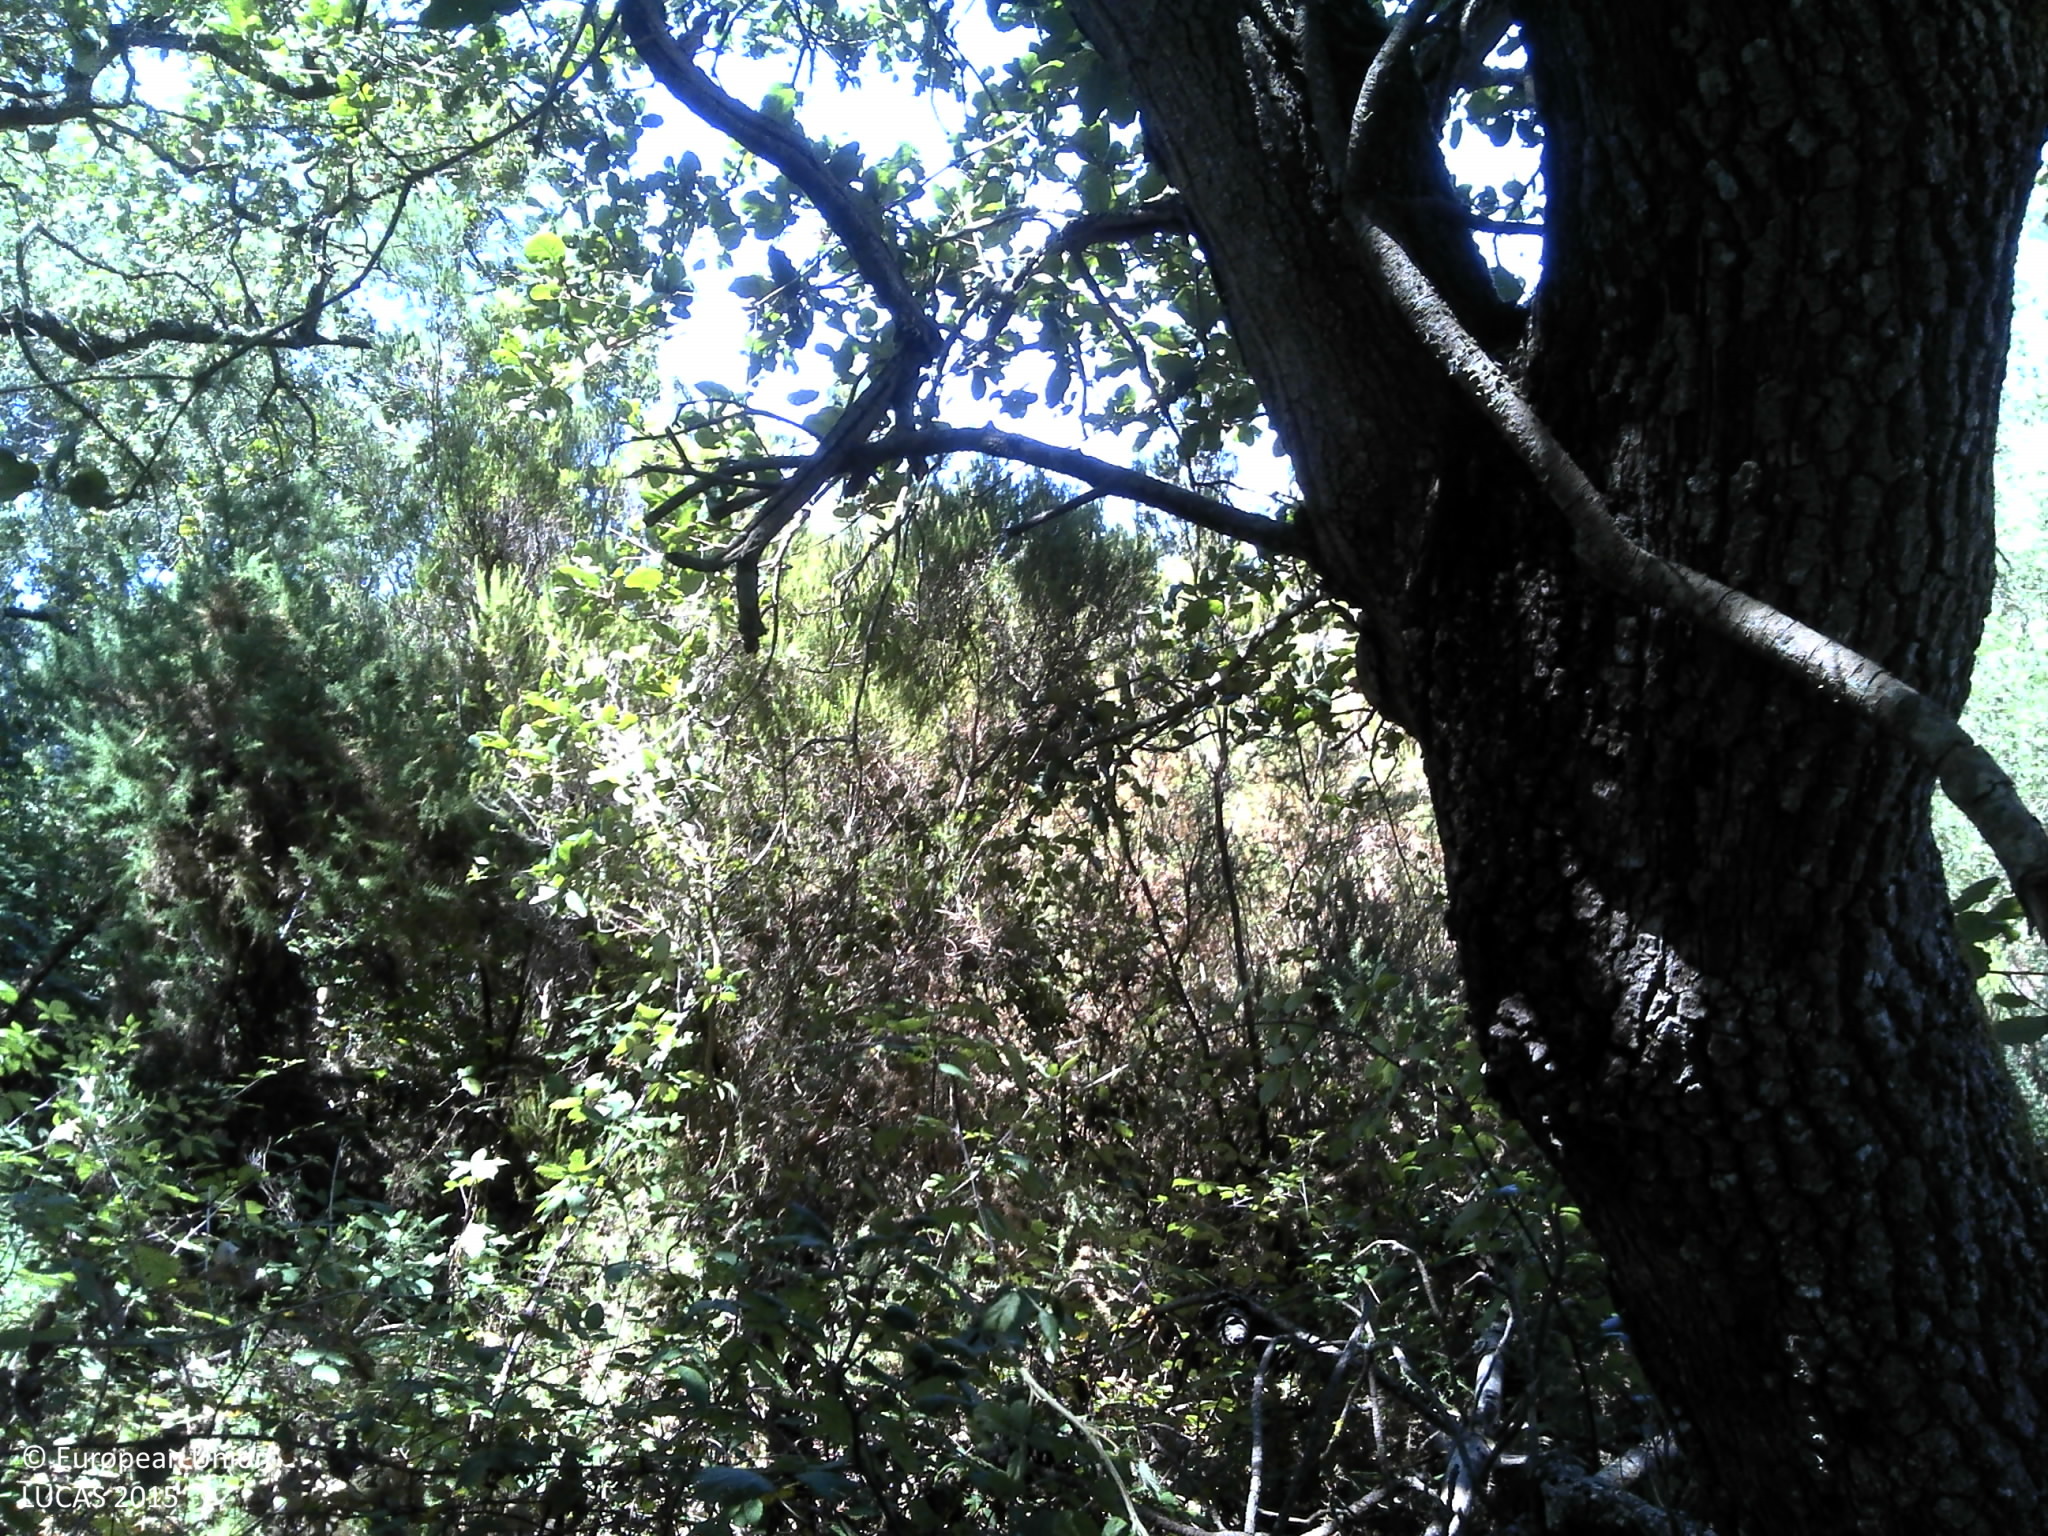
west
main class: Woodland
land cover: Broadleaved woodland
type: broadleaved evergreen forest
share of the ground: 50 - 75 %
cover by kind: broadleaved forest trees 65 %, shrubs 20 %, unconsolidated bare surface 10 %
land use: Forestry
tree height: > 5 m
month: July
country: PT
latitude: 38.9265
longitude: -9.1941
